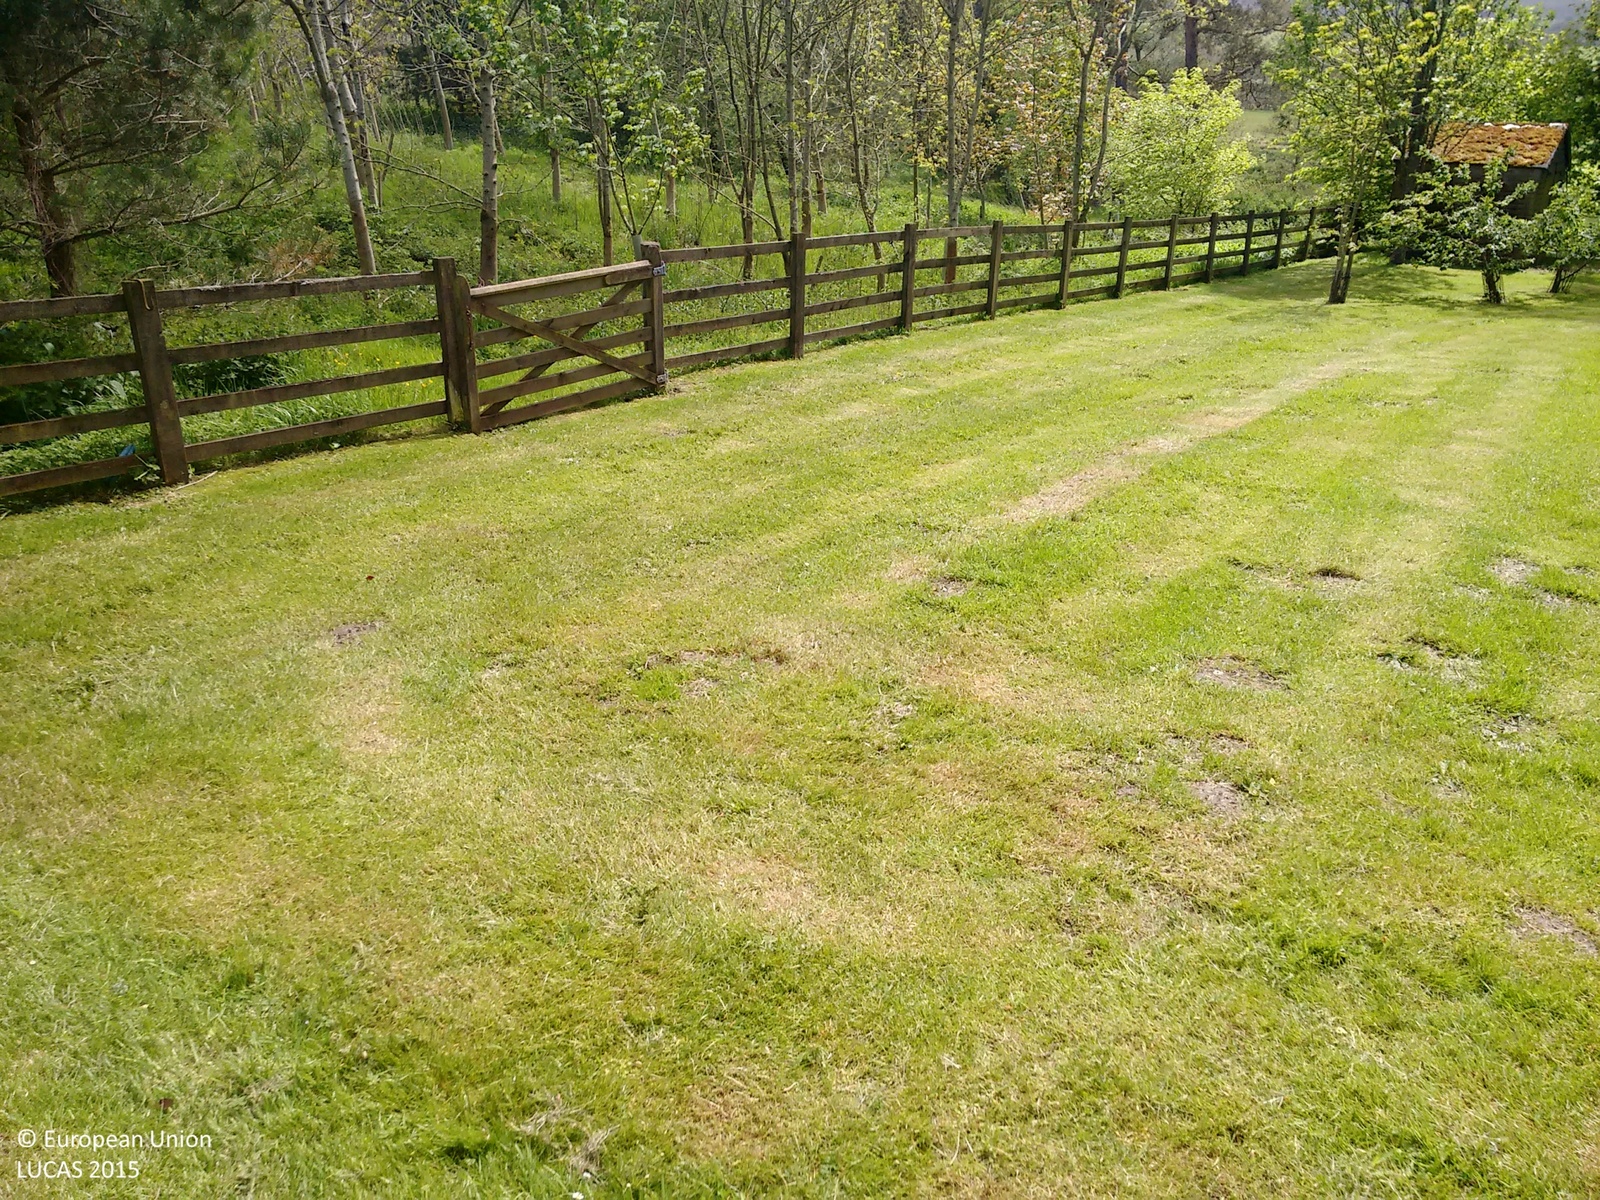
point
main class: Grassland
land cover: Grassland with sparse tree/shrub cover
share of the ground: > 75 %
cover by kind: herbaceous plants 95 %, broadleaved forest trees 5 %
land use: Residential
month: May
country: GB
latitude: 55.1547
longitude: -2.3157
